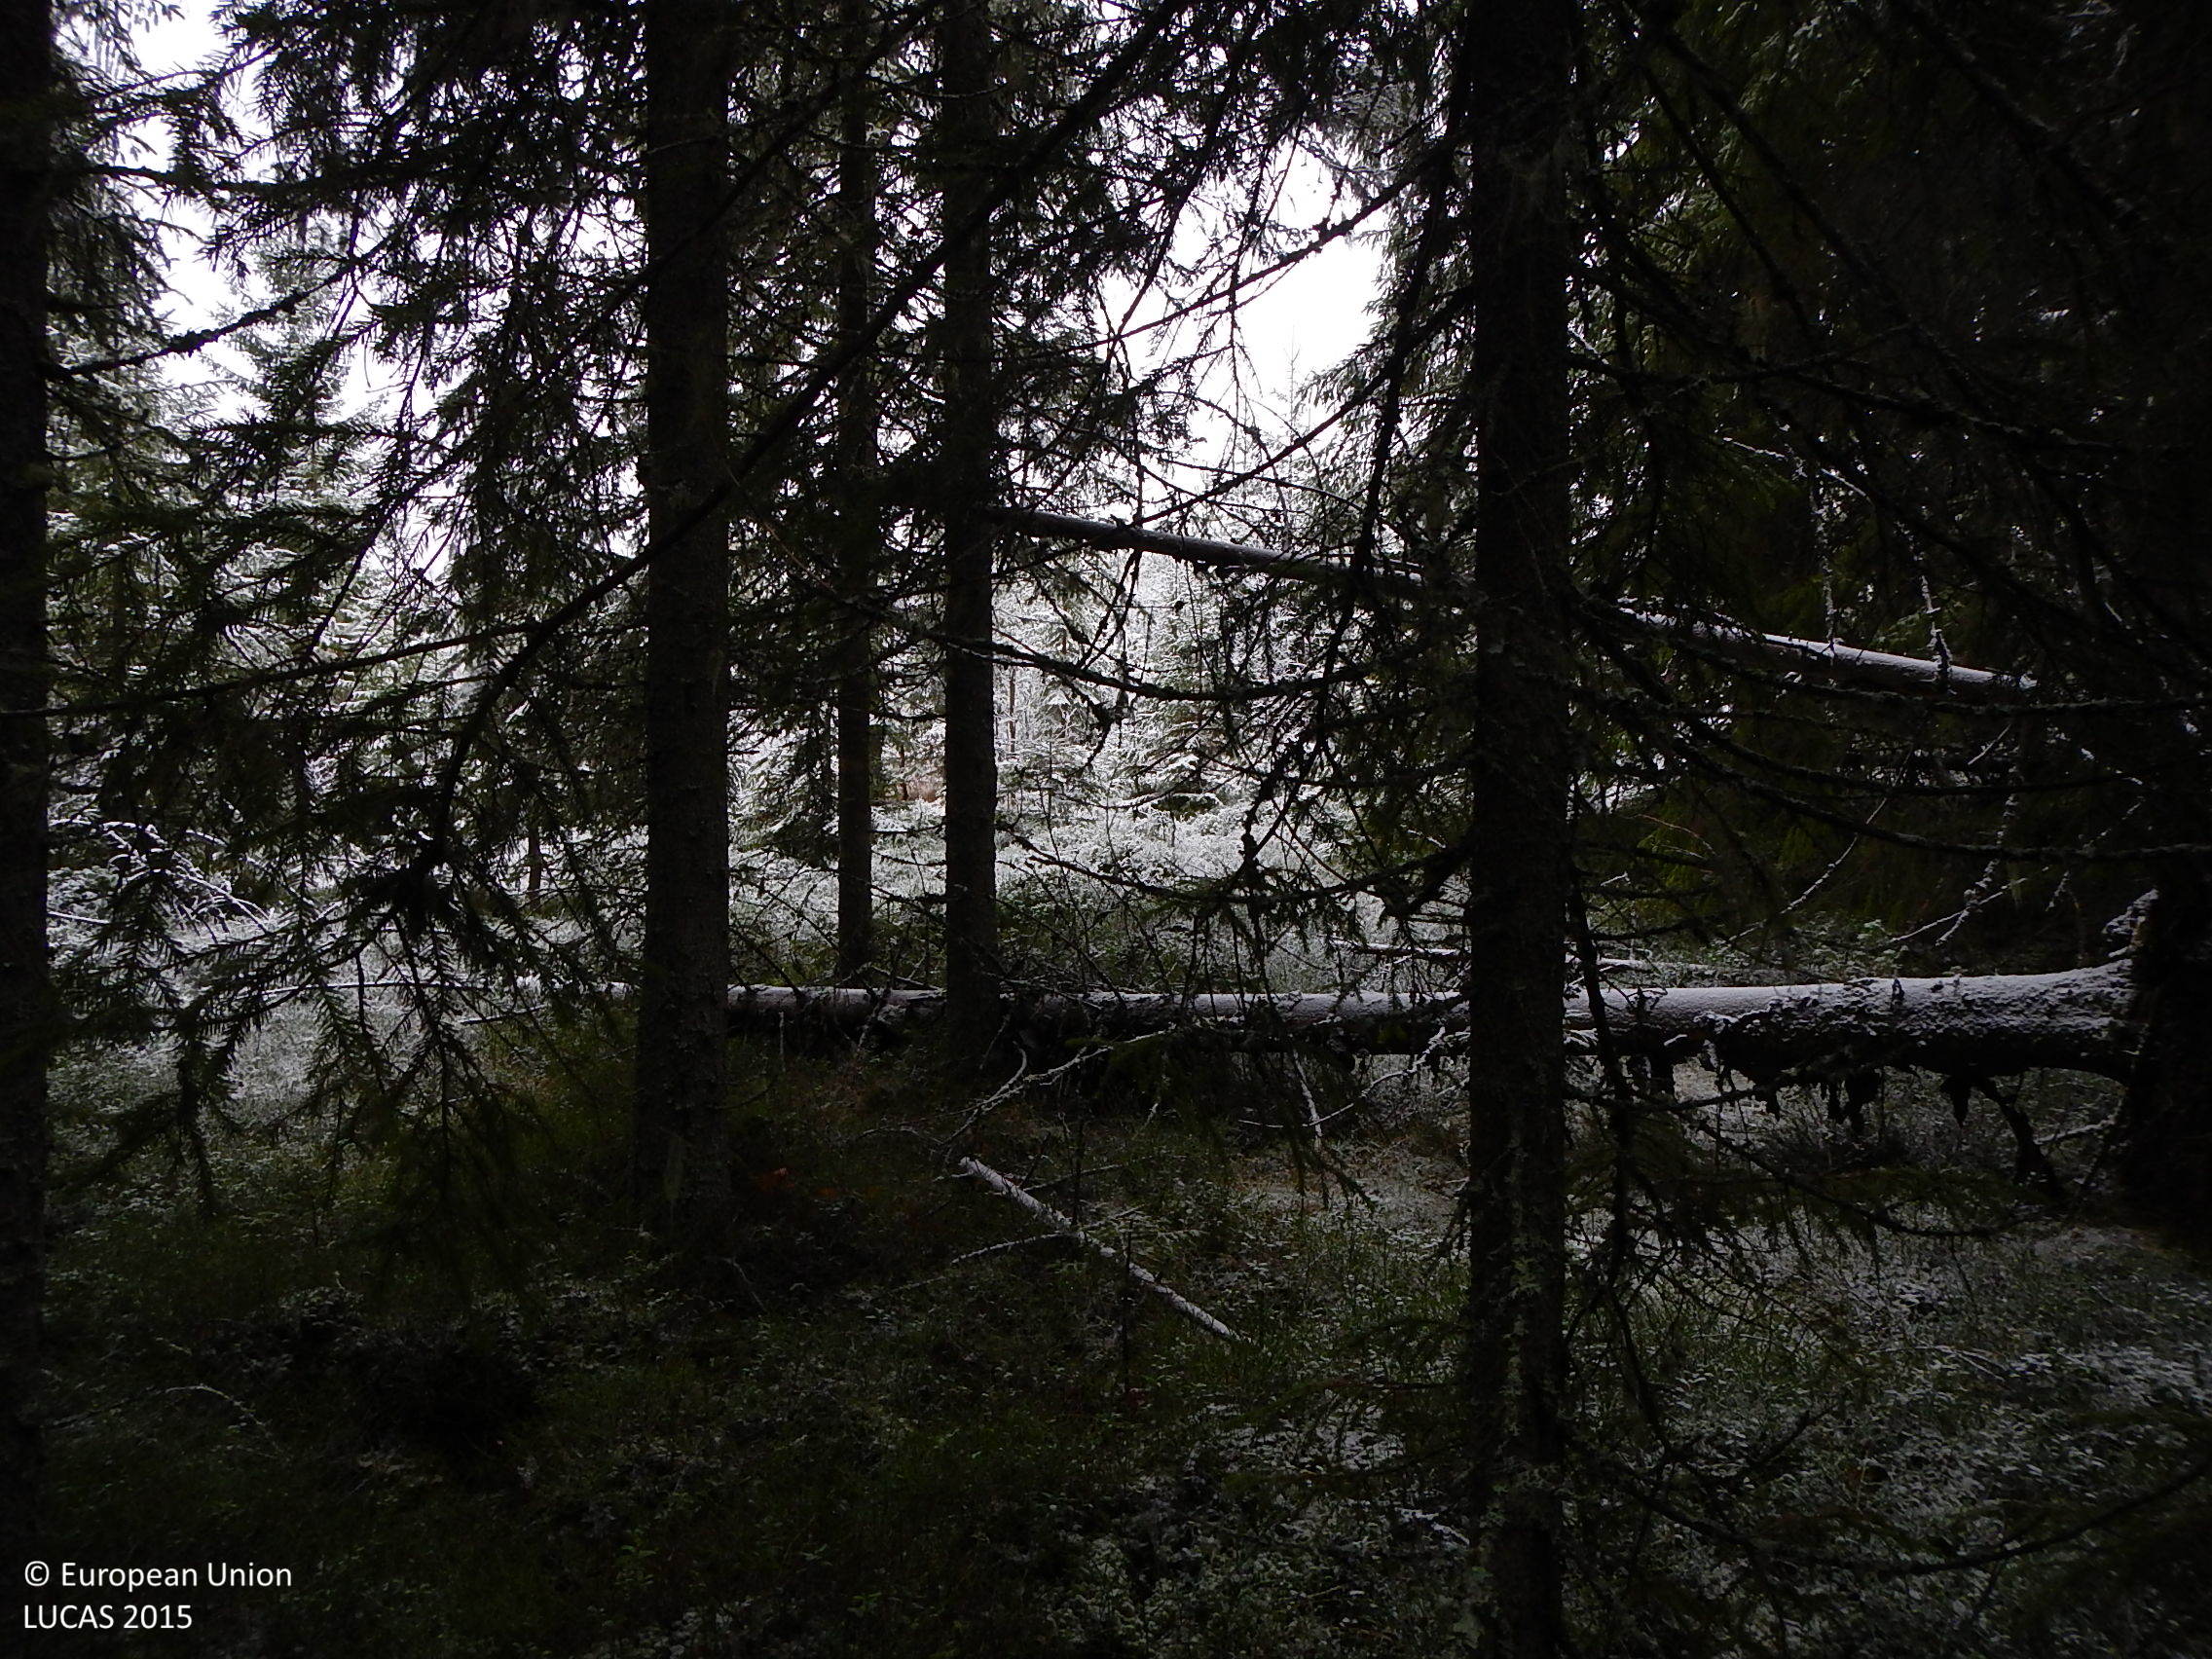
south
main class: Woodland
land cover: Spruce dominated coniferous woodland
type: boreal forest
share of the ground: > 75 %
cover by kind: coniferous forest trees 80 %, shrubs 10 %, lichens and mosses 10 %
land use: Forestry
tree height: > 5 m
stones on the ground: < 10 %
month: November
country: SE
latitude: 61.7904
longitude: 15.4633
